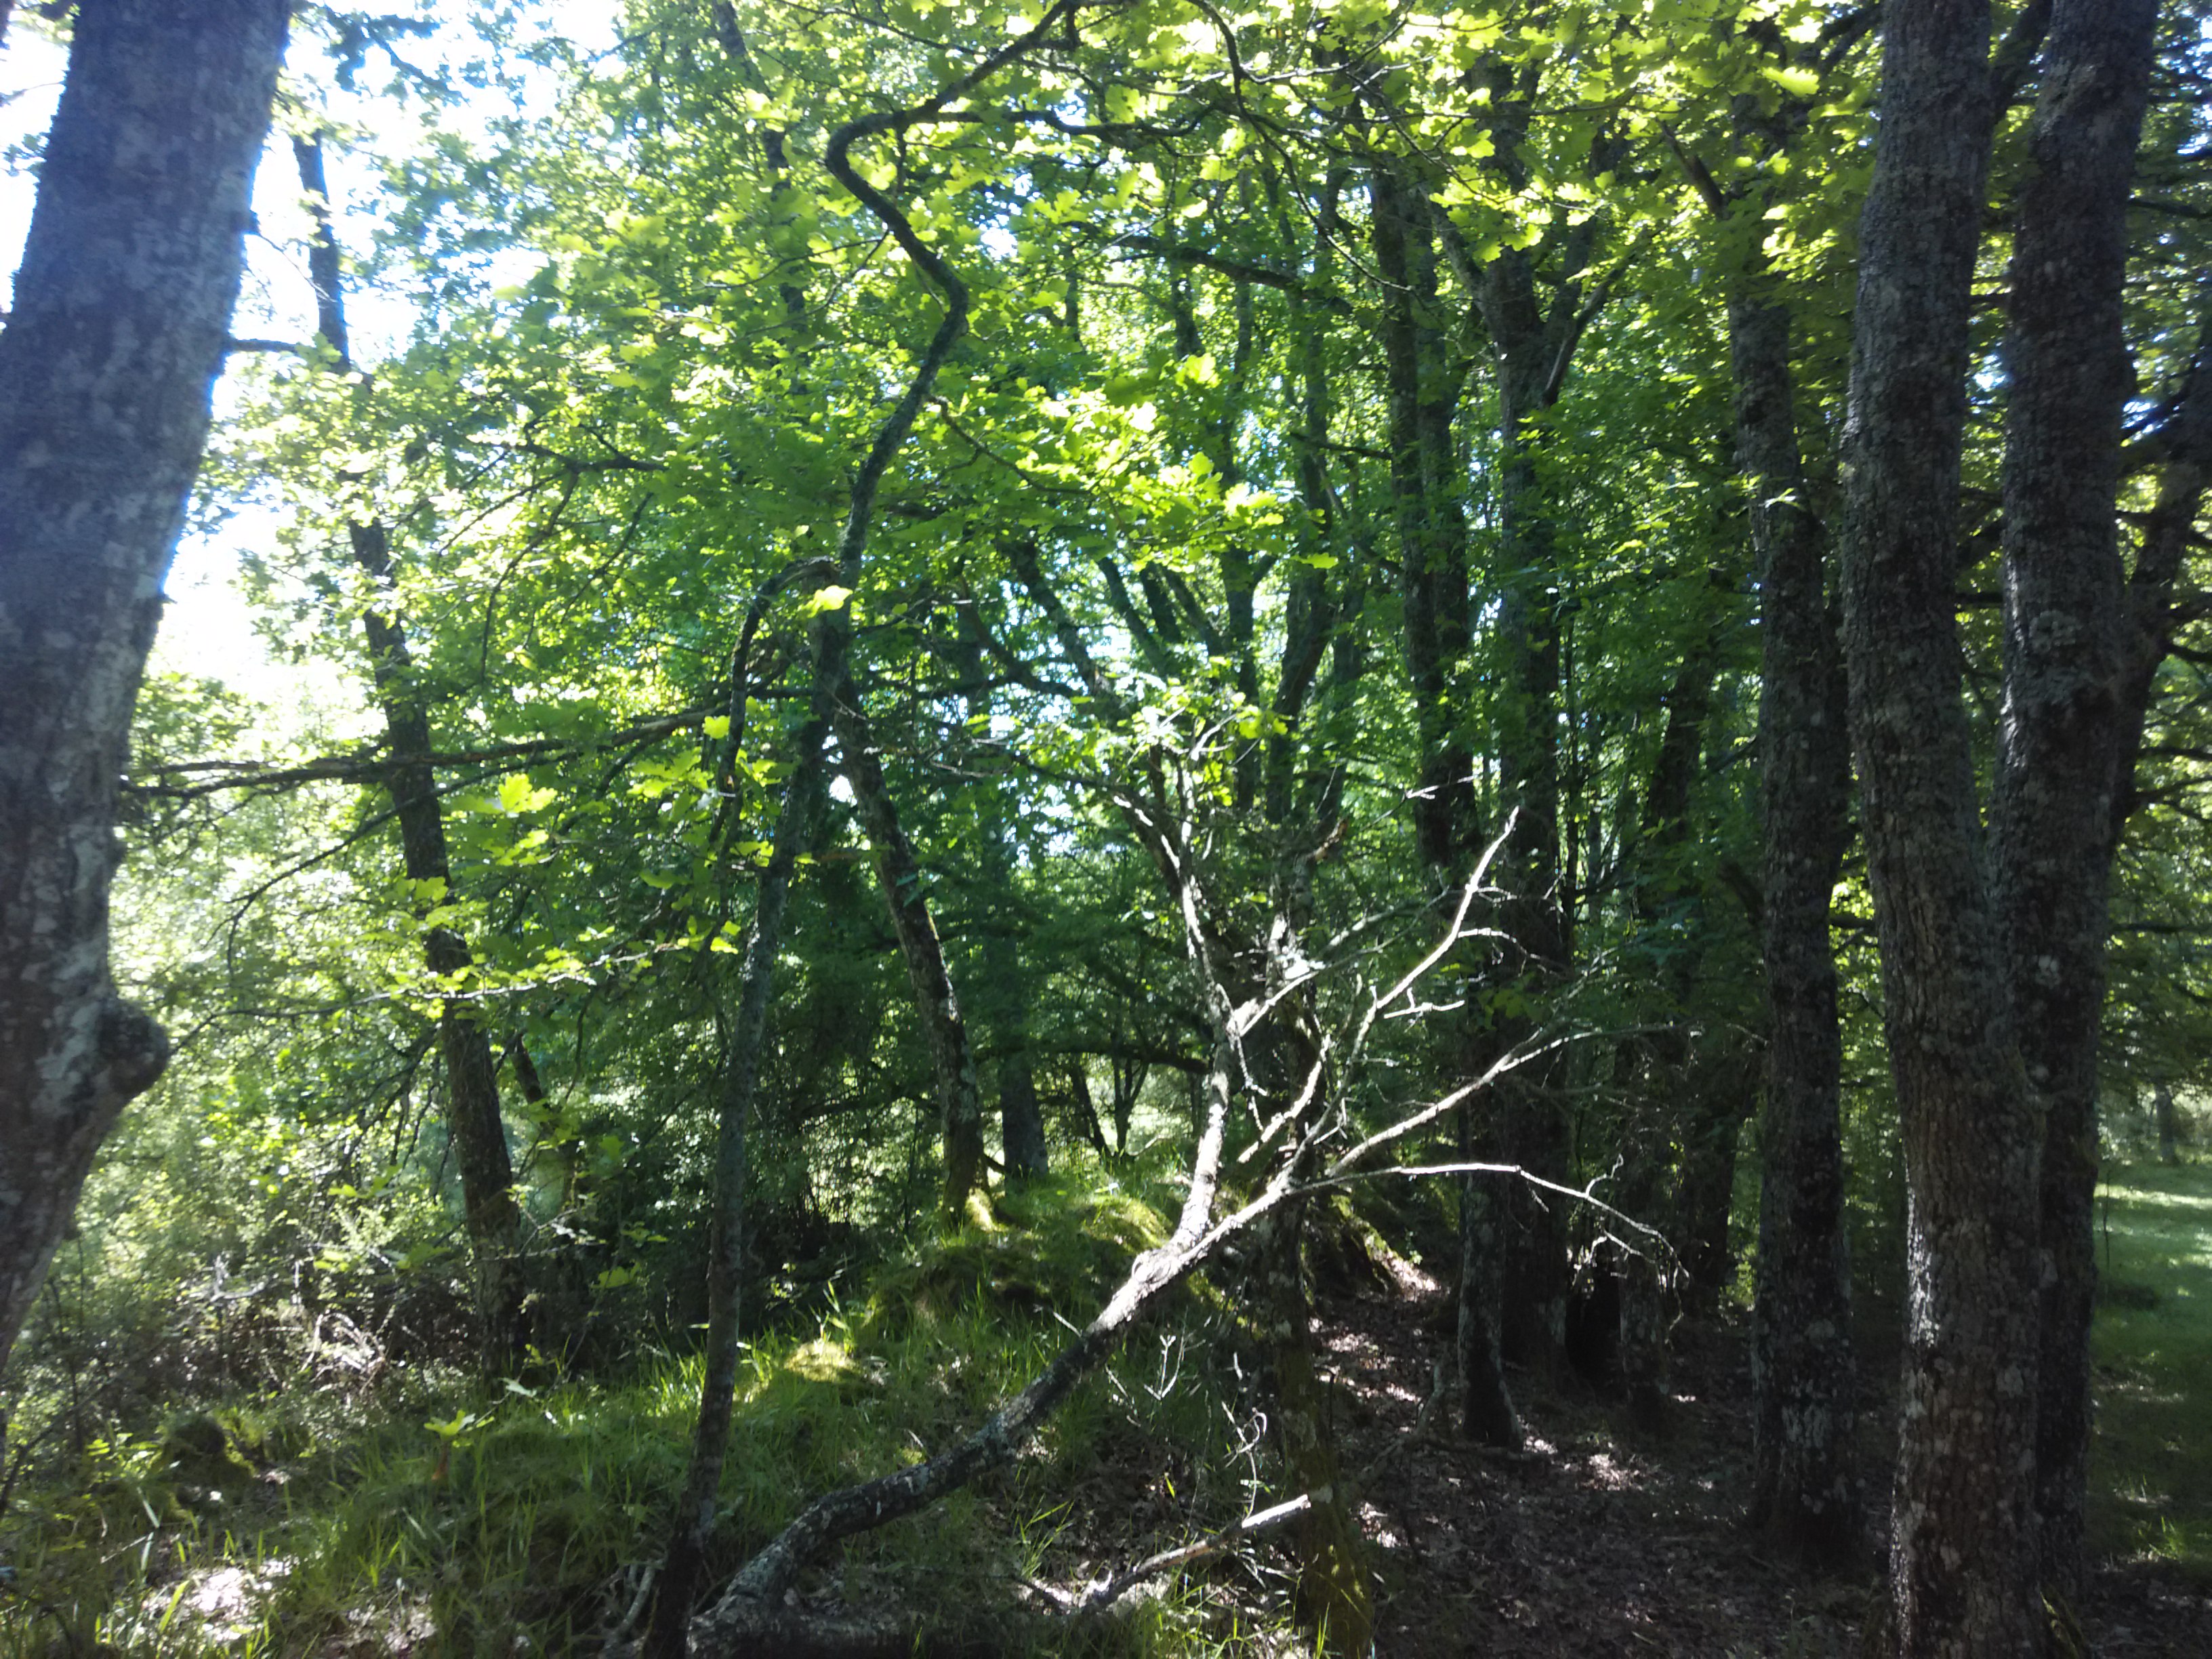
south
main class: Woodland
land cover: Broadleaved woodland
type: acidophilous oak and oak-birch forest
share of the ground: 50 - 75 %
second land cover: Grassland without tree/shrub cover
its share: 25 - 50 %
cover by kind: broadleaved forest trees 50 %, herbaceous plants 35 %, consolidated bare surface 10 %, shrubs 5 %
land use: Forestry
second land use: Agriculture (excluding fallow land and kitchen gardens)
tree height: > 5 m
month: June
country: ES
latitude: 42.9303
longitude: -2.5361
